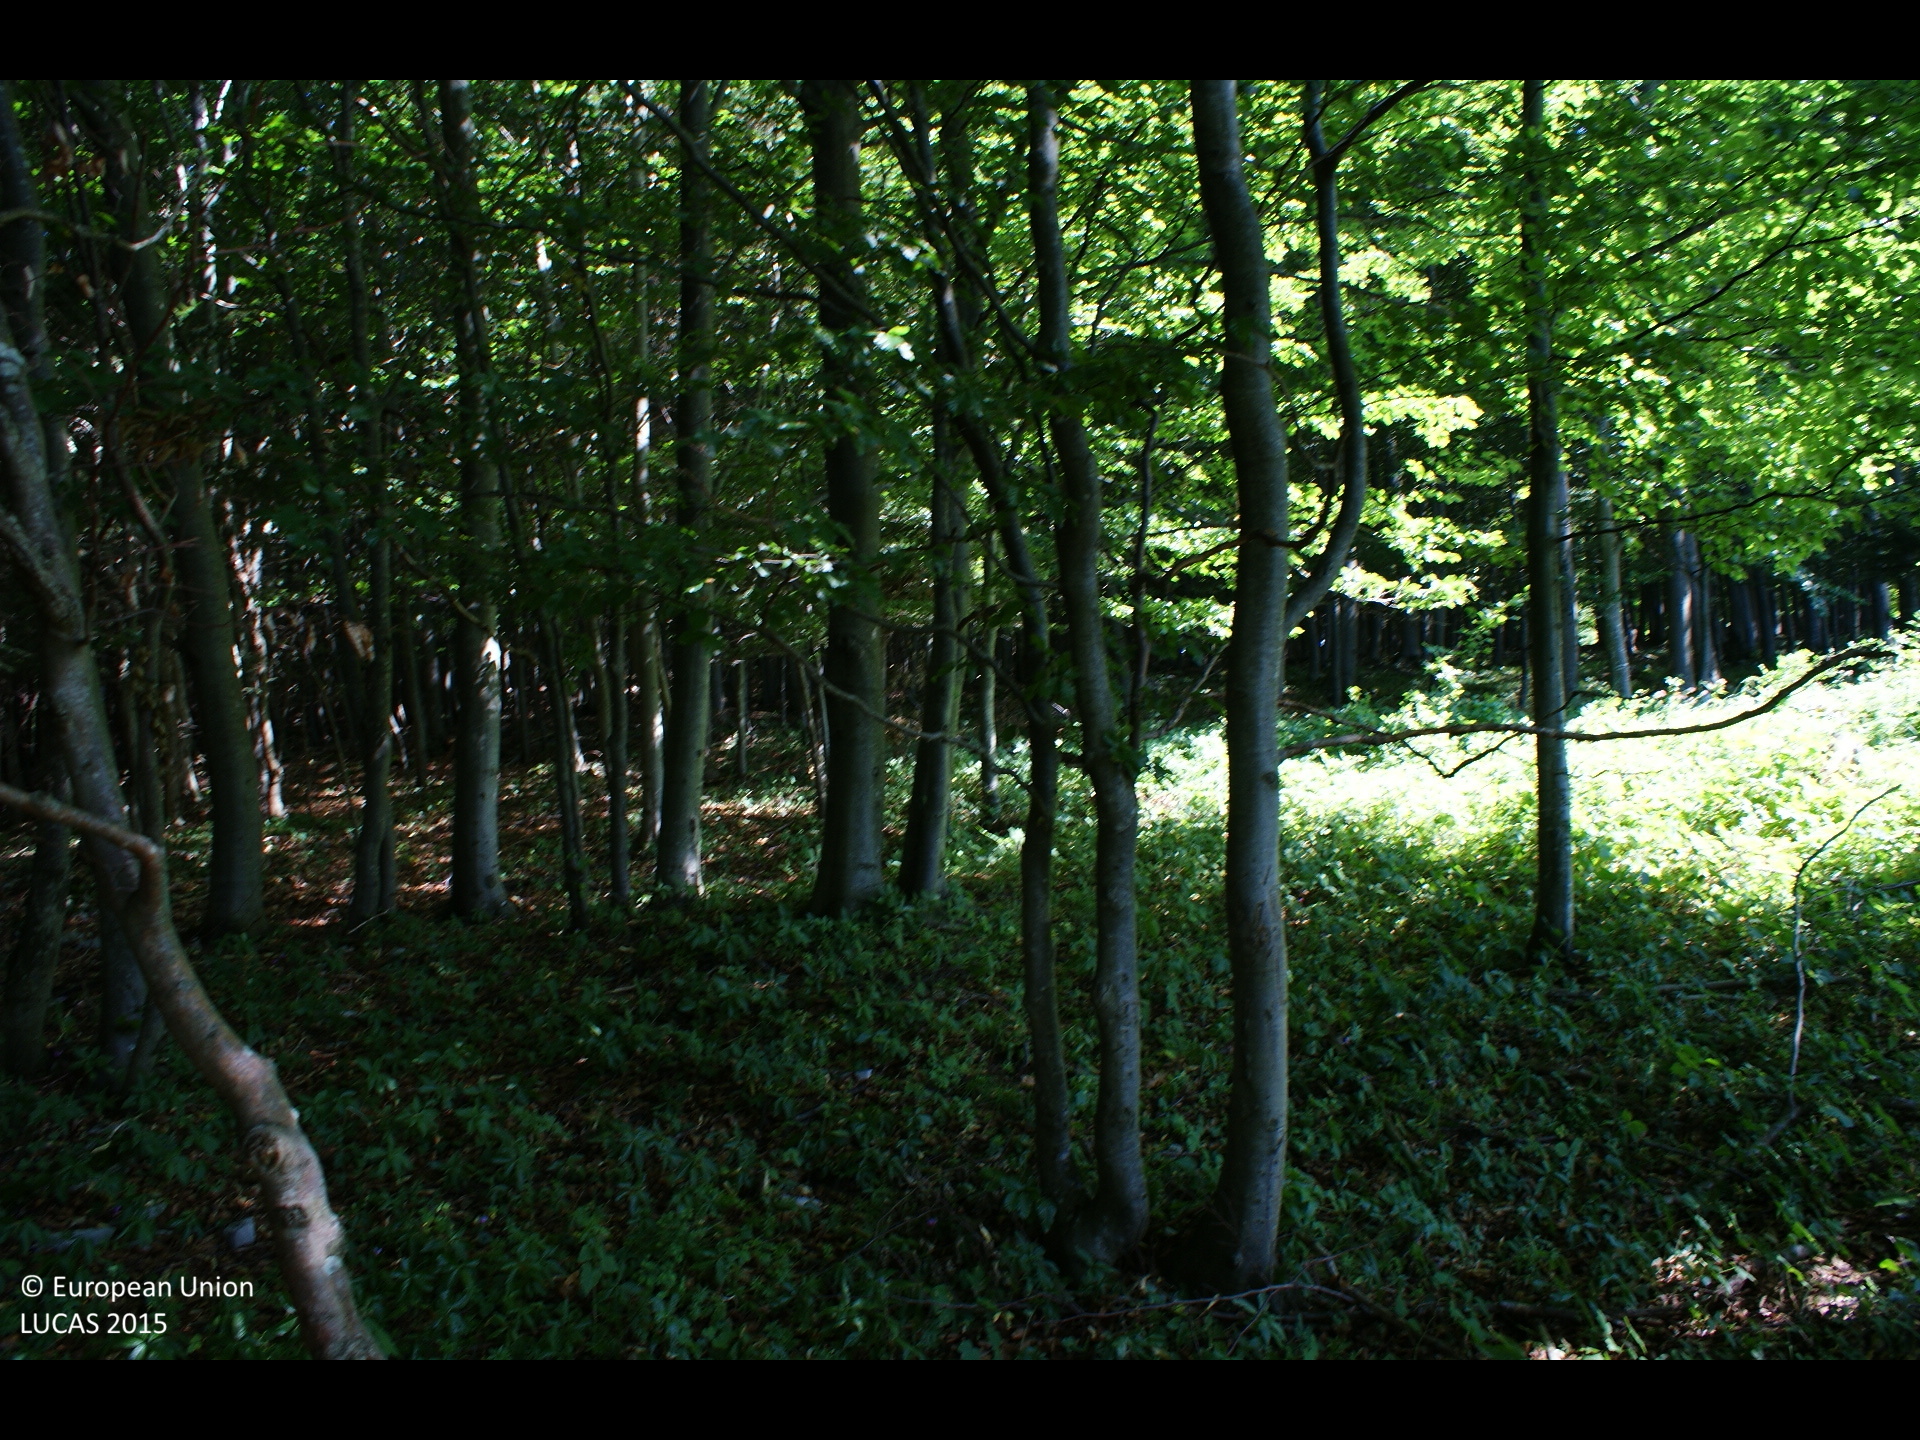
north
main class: Woodland
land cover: Broadleaved woodland
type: mountainous beech forest
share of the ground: > 75 %
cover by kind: broadleaved forest trees 80 %, coniferous forest trees 10 %, herbaceous plants 10 %
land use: Forestry
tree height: > 5 m
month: July
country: AT
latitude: 47.9702
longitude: 15.2924
